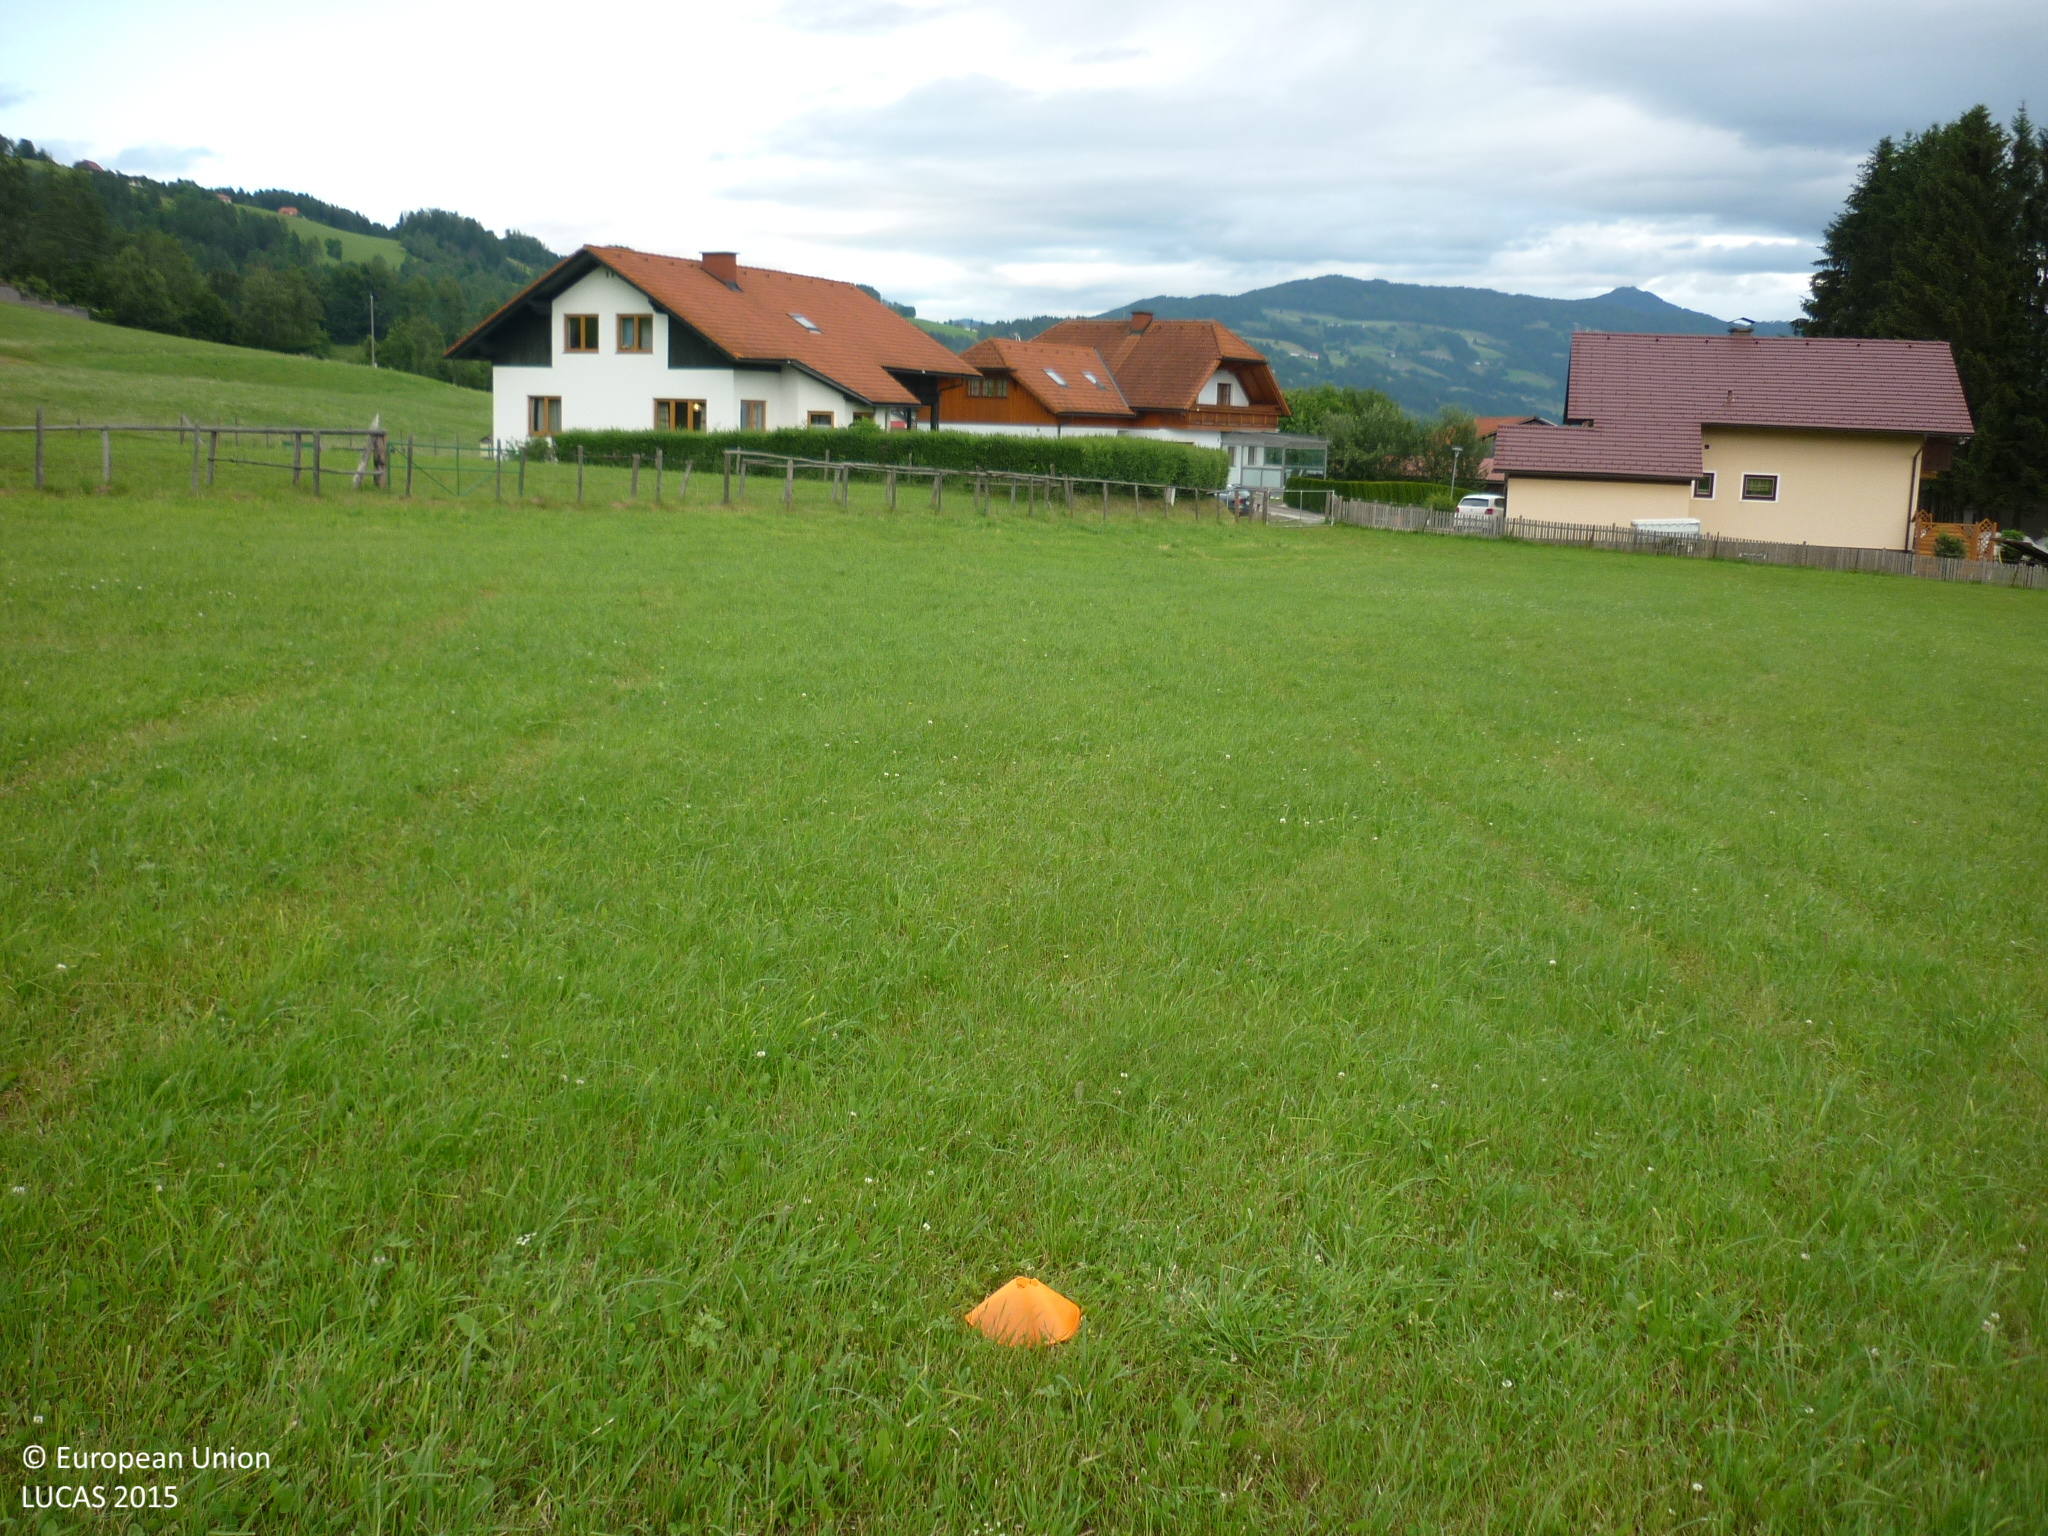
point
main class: Grassland
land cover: Grassland without tree/shrub cover
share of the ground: > 75 %
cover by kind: herbaceous plants 100 %
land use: Agriculture (excluding fallow land and kitchen gardens)
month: June
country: AT
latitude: 47.1901
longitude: 14.1557
